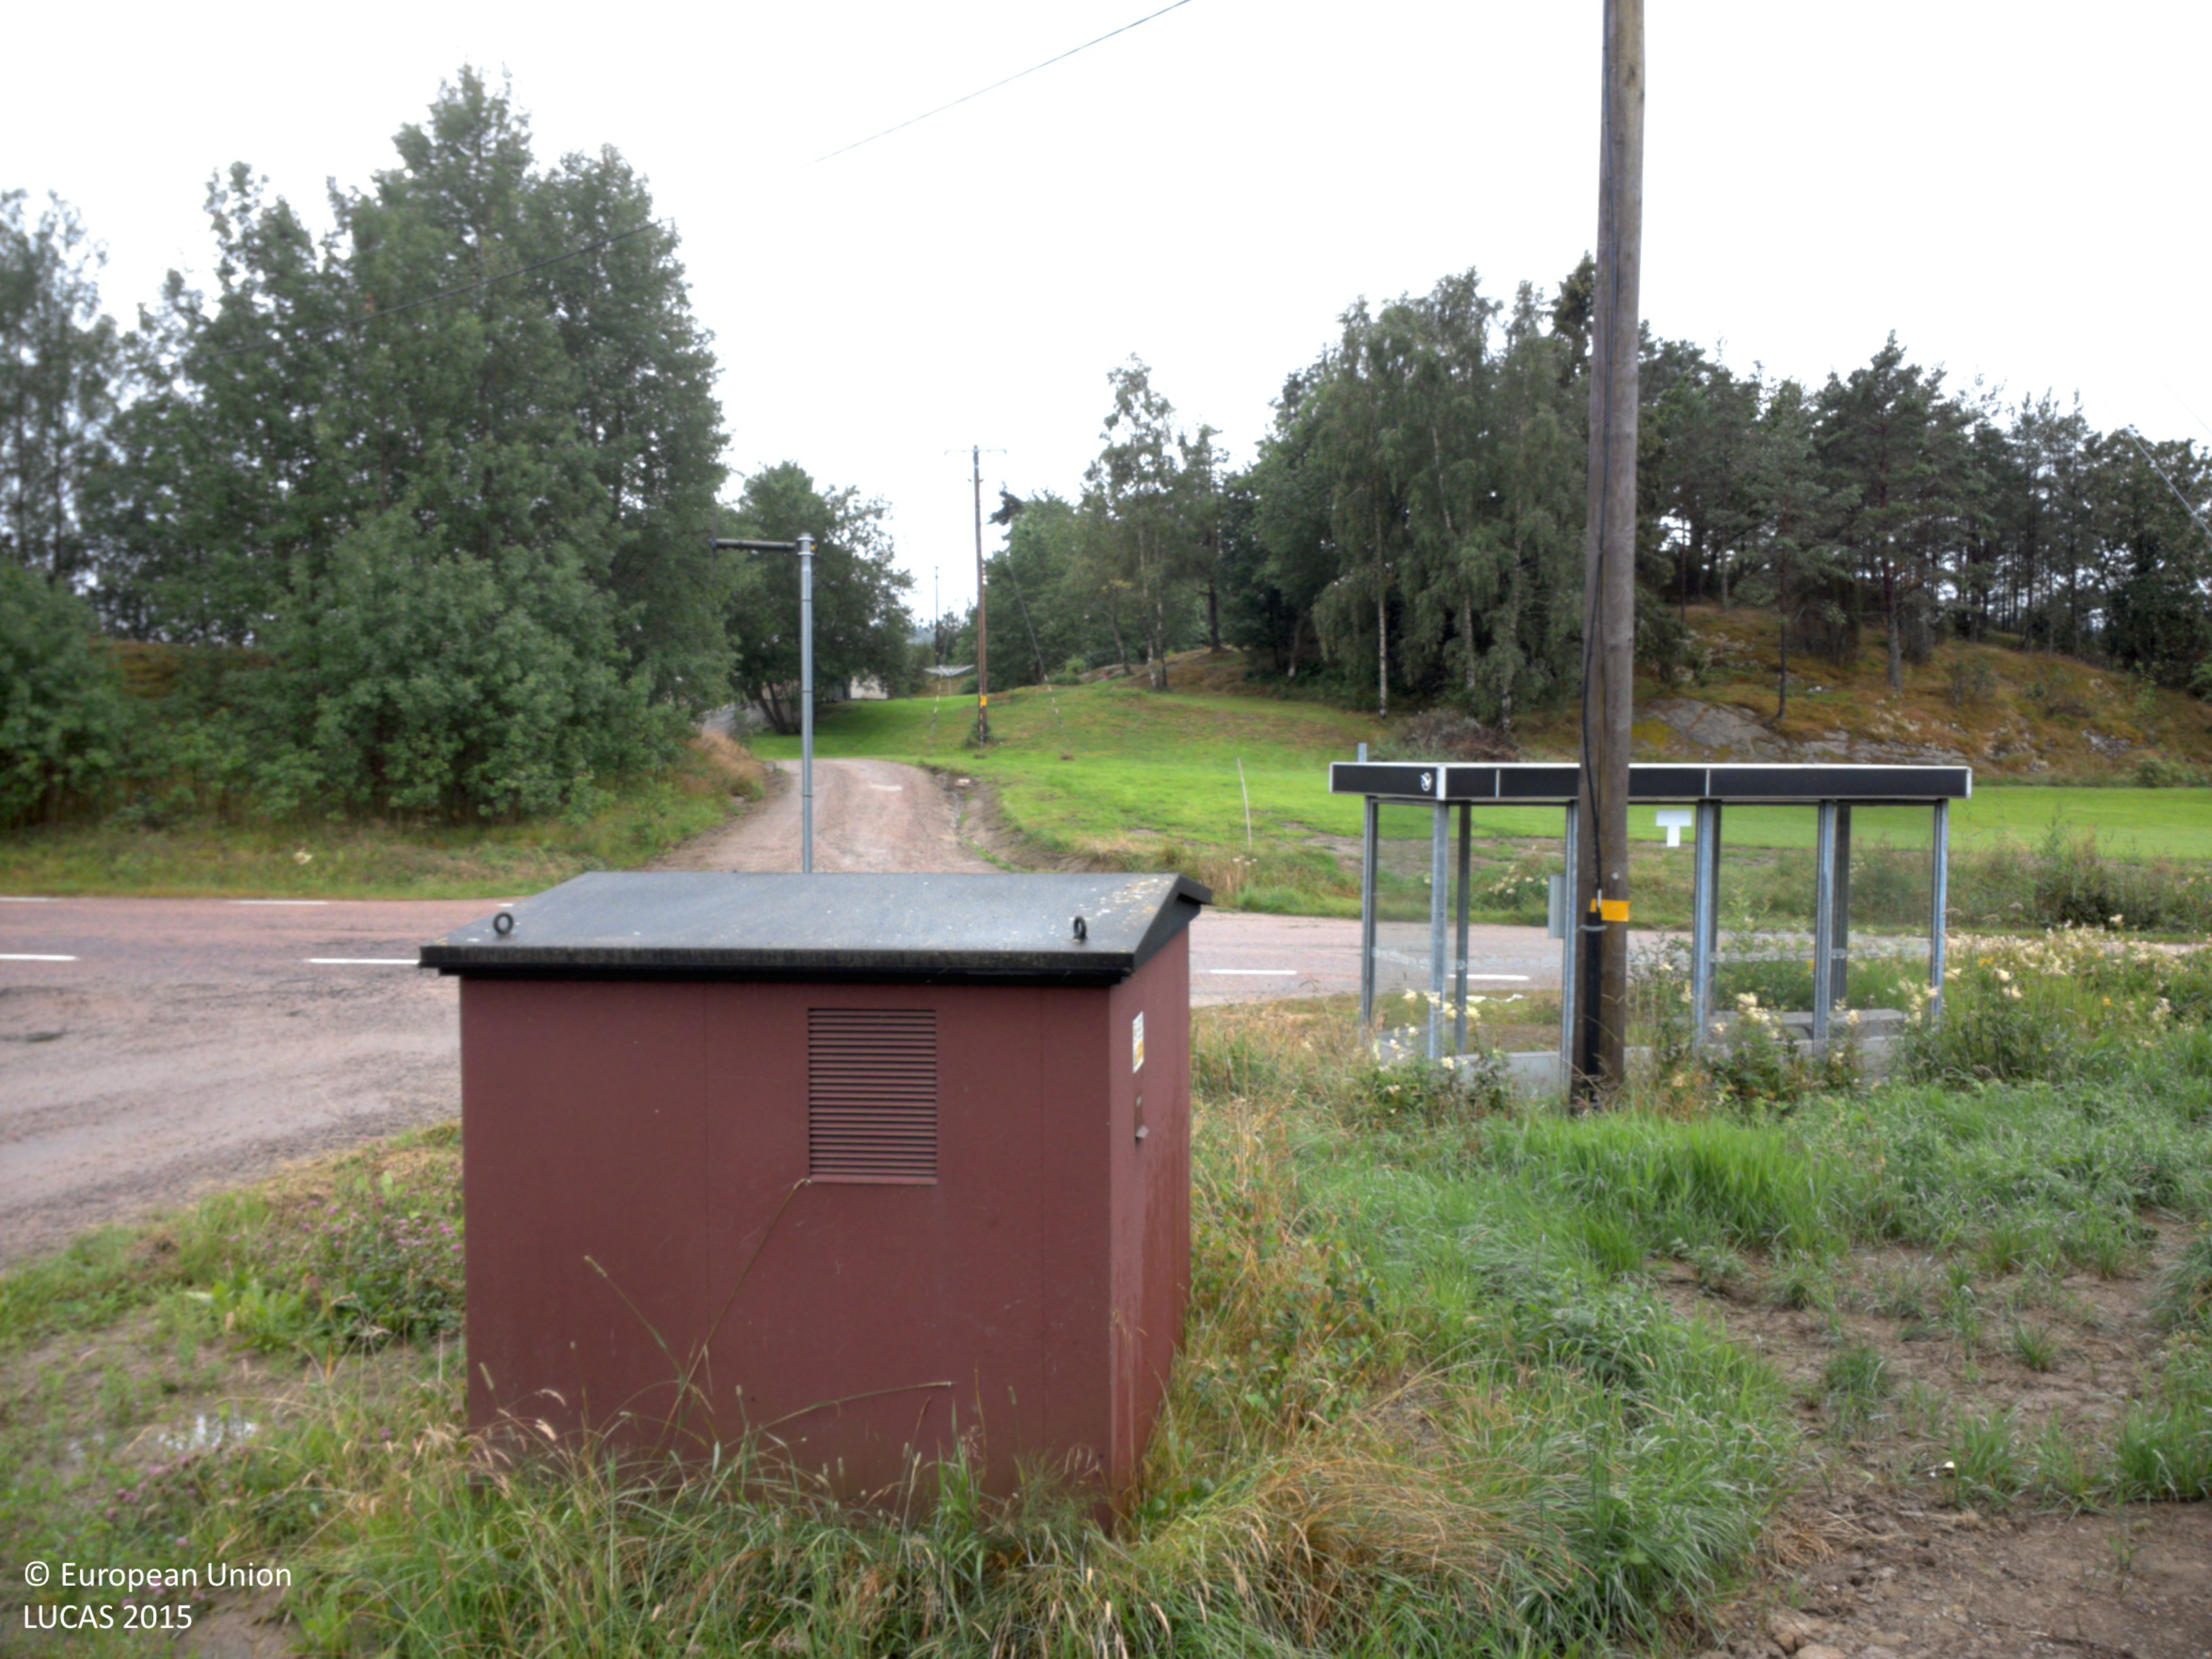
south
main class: Grassland
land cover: Grassland without tree/shrub cover
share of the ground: > 75 %
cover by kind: herbaceous plants 95 %, shrubs 5 %
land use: Abandoned areas
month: July
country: SE
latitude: 58.2947
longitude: 11.9921
